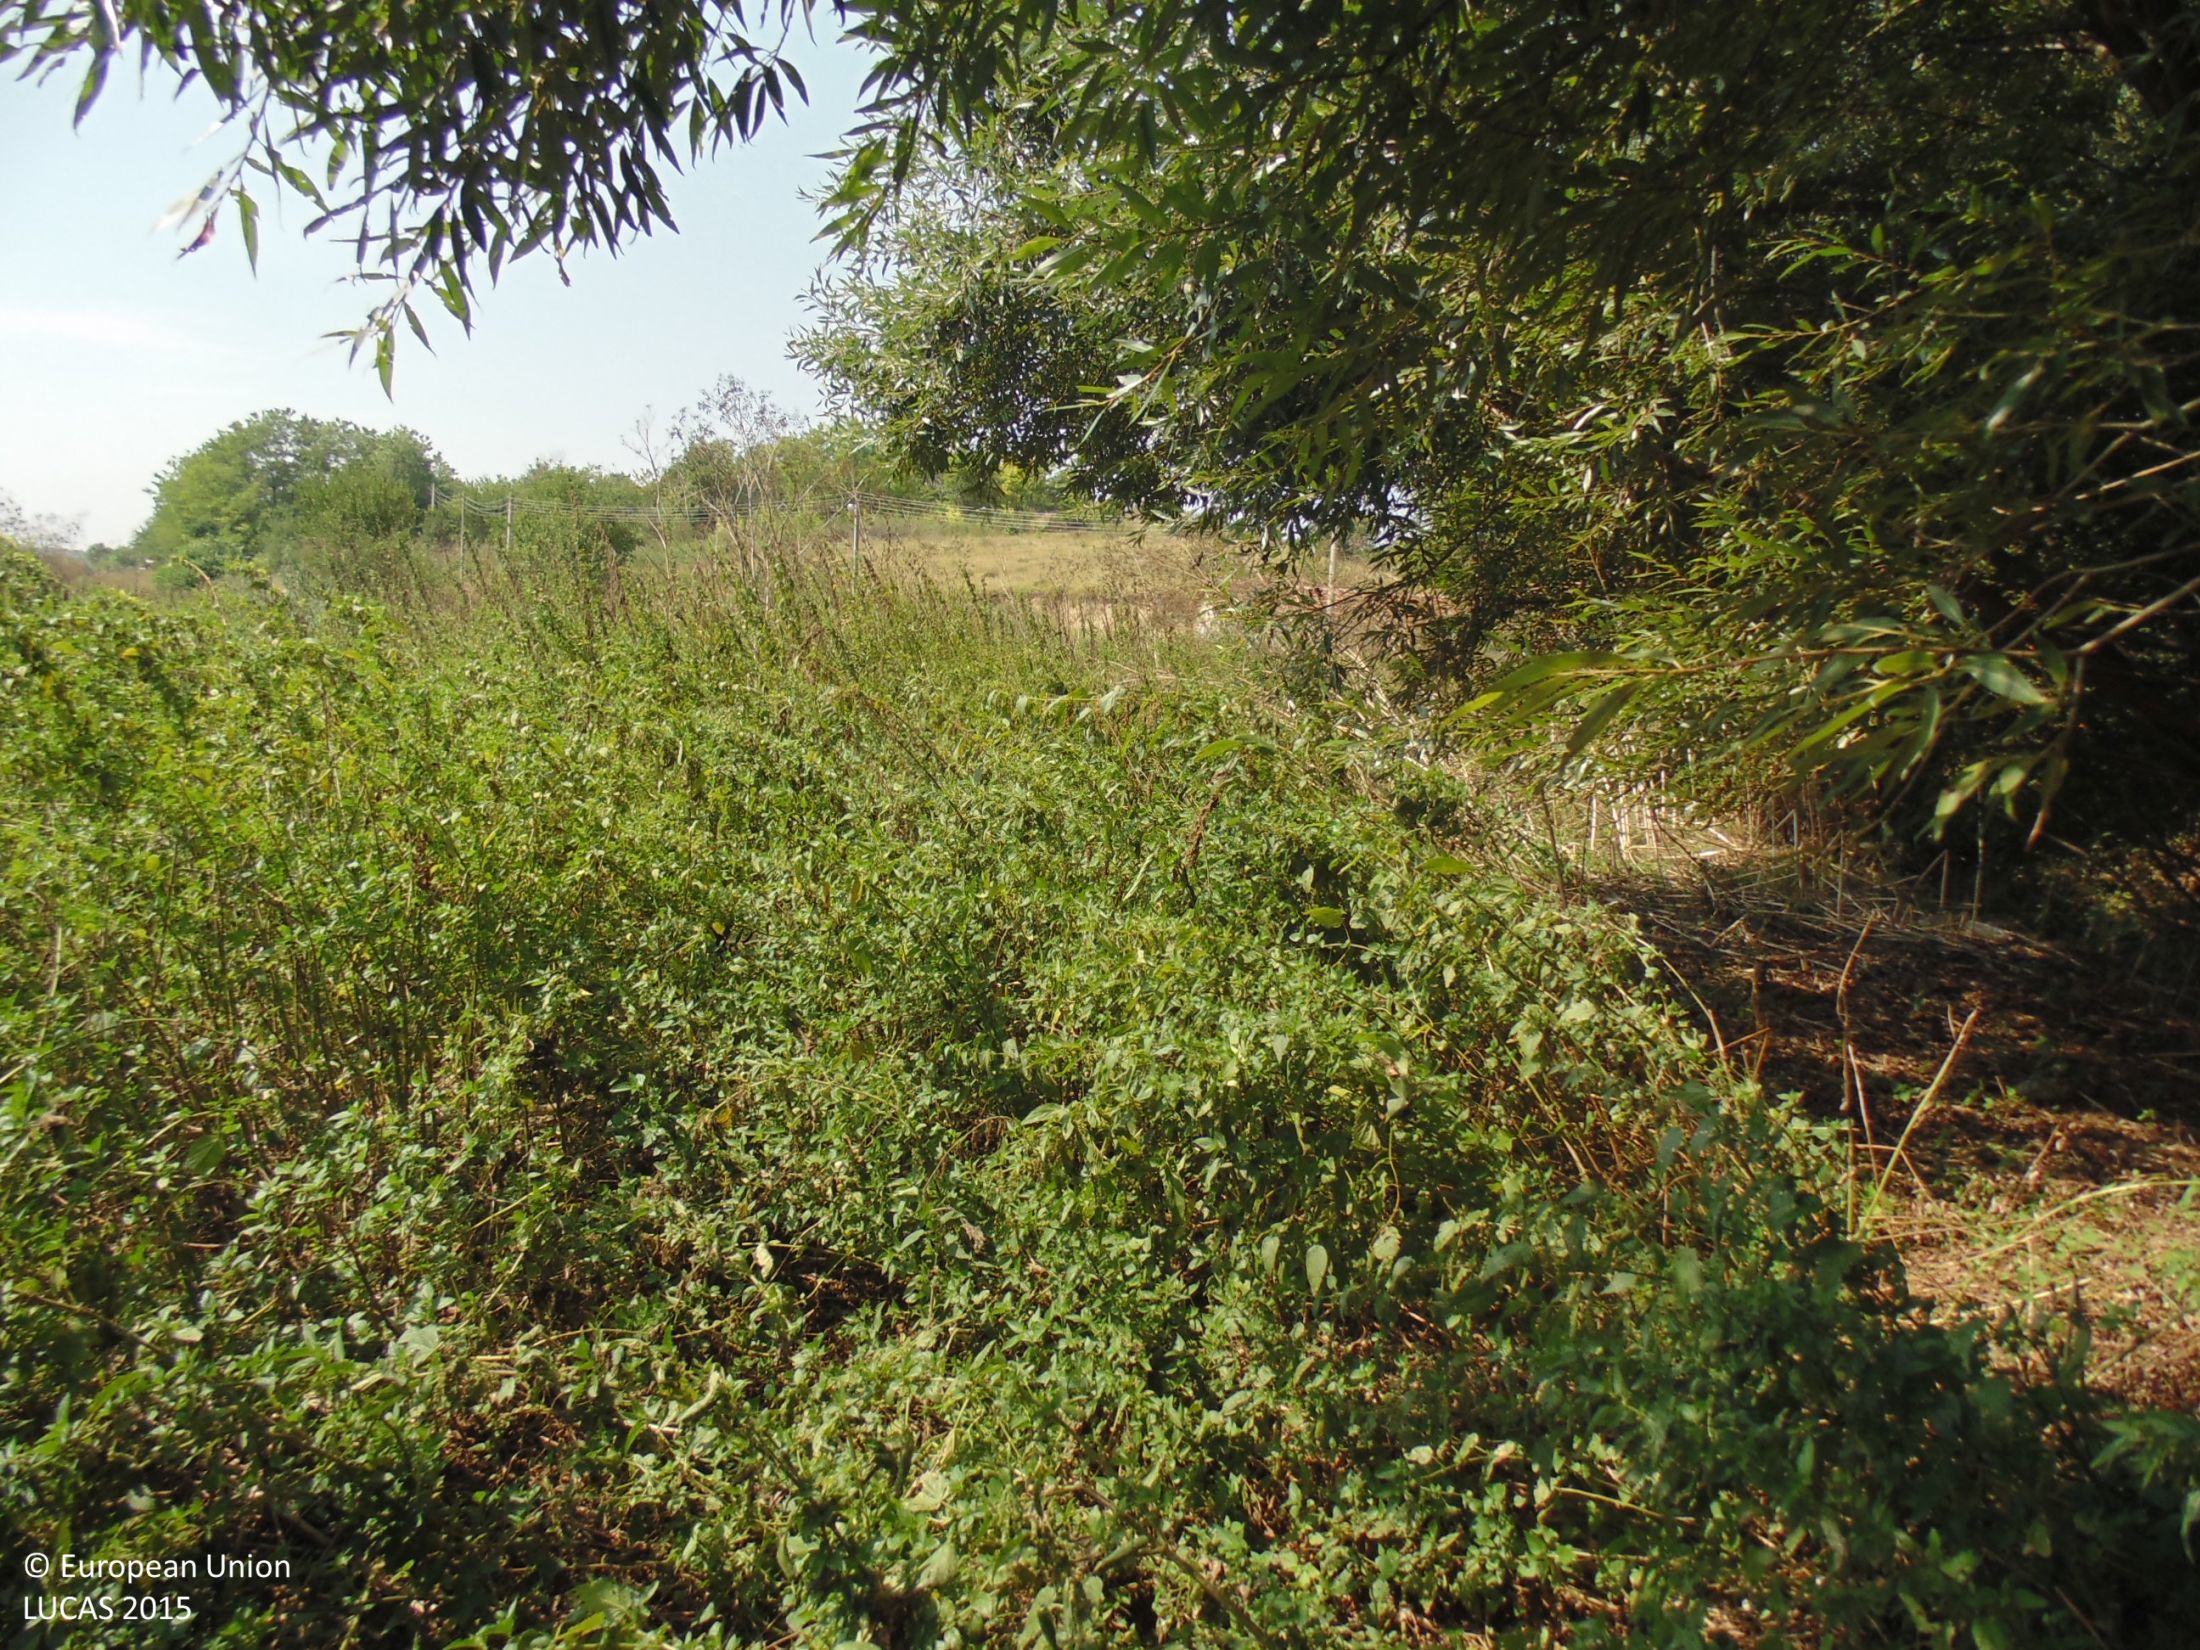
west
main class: Woodland
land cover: Broadleaved woodland
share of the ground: 50 - 75 %
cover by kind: broadleaved forest trees 50 %, herbaceous plants 45 %, shrubs 5 %
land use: Semi-natural and natural areas not in use
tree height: > 5 m
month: August
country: BG
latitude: 44.0195
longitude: 27.3357
